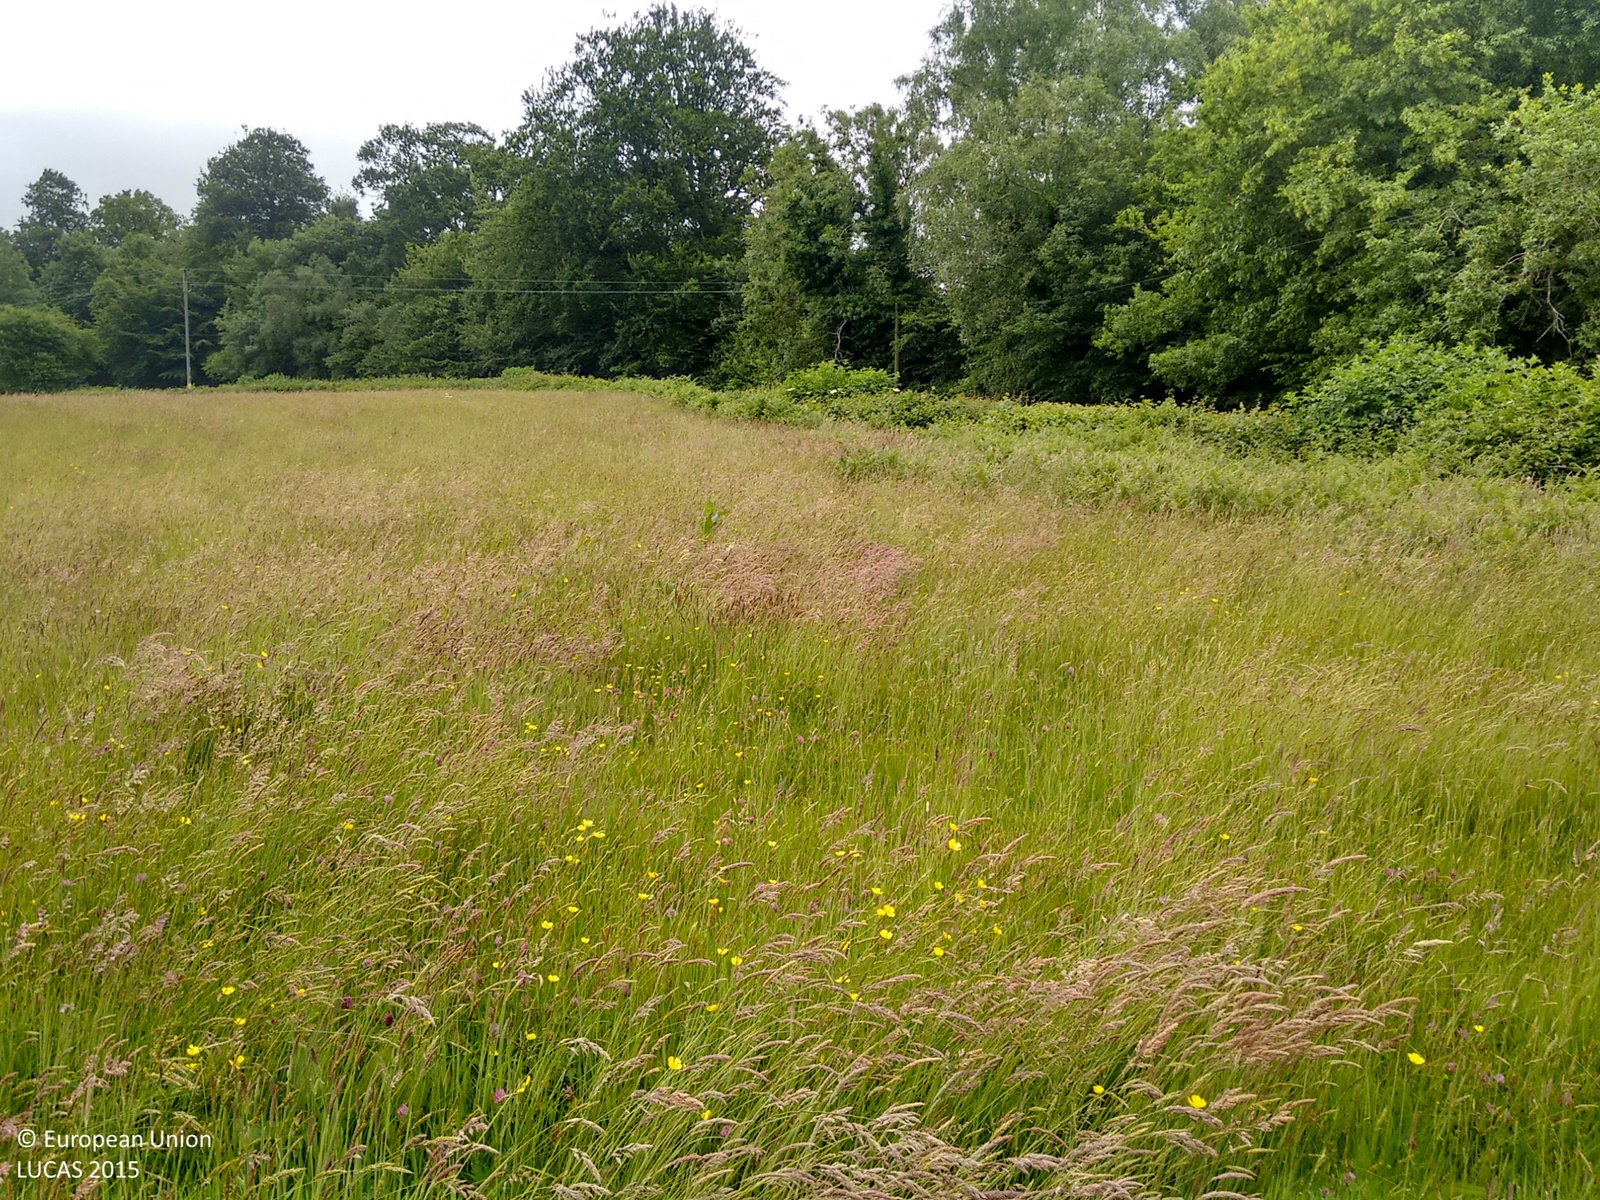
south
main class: Grassland
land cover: Grassland without tree/shrub cover
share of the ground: > 75 %
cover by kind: herbaceous plants 100 %
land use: Agriculture (excluding fallow land and kitchen gardens)
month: June
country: GB
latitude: 50.9214
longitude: 0.4261
